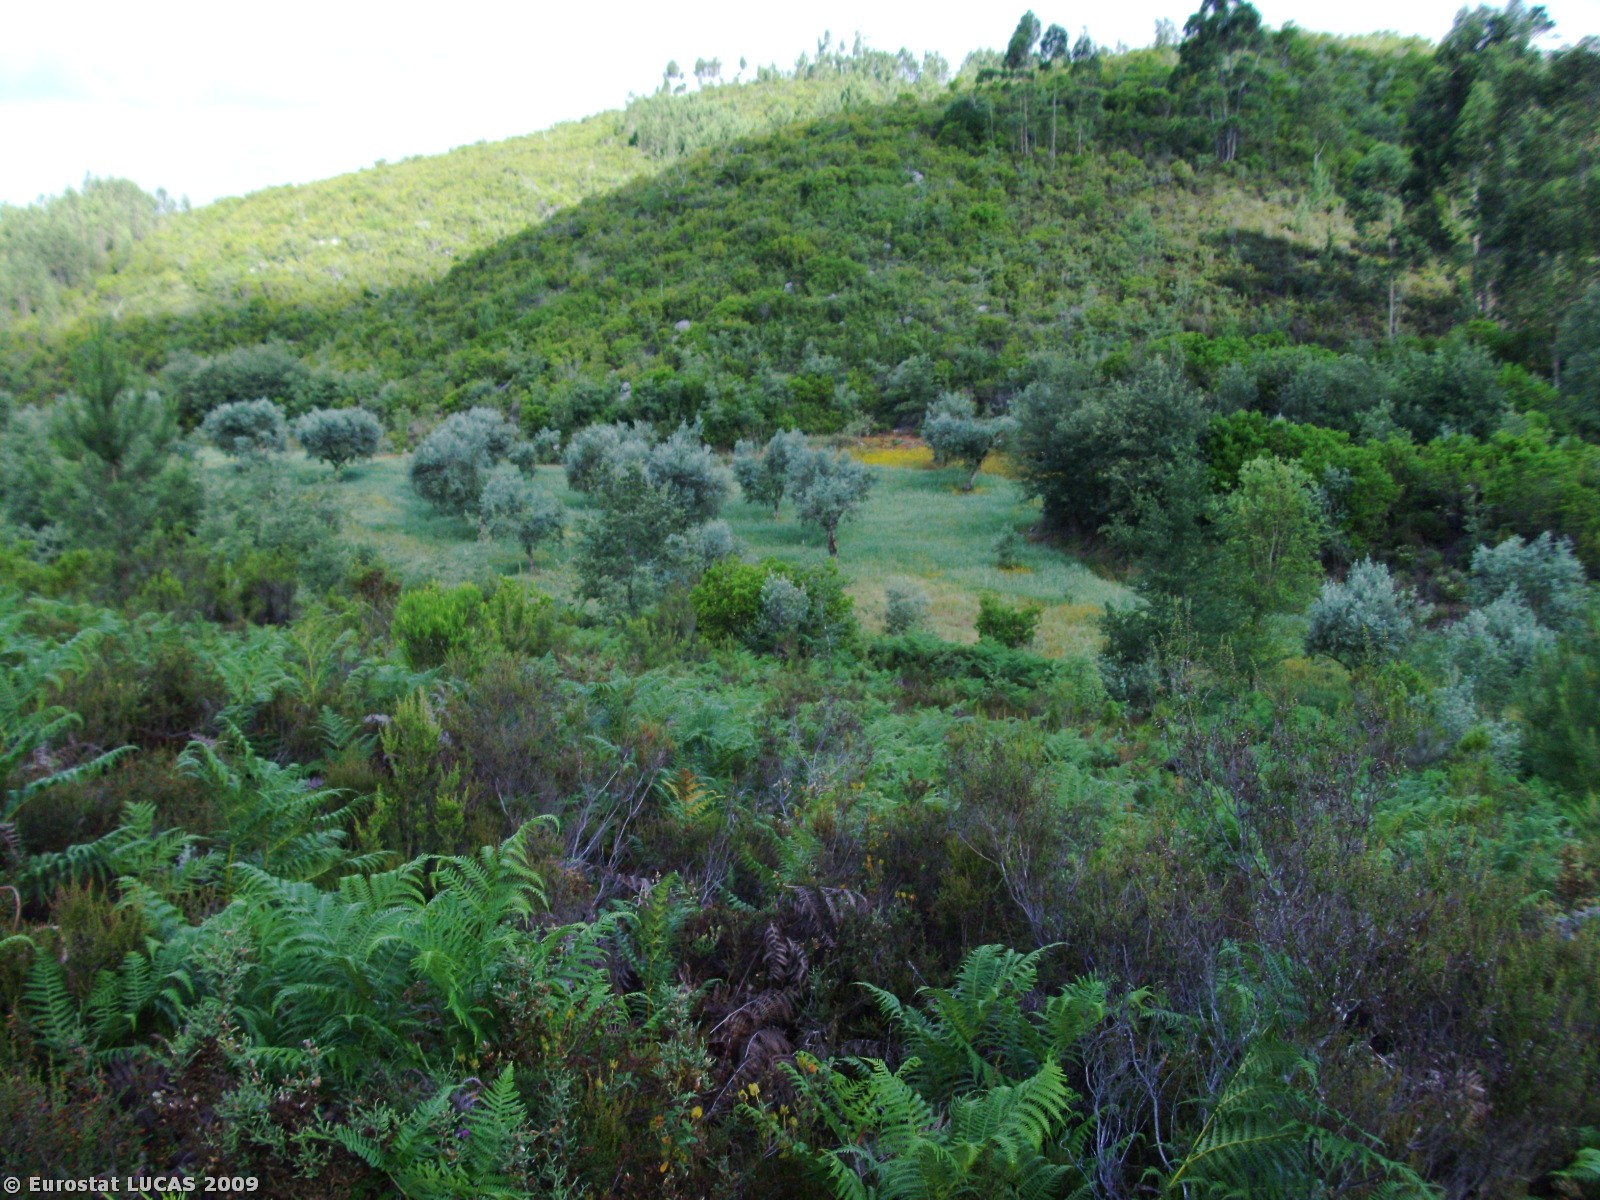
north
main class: Shrubland
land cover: Shrubland with sparse tree cover
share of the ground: > 75 %
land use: Unused
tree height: > 5 m
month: June
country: PT
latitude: 39.8484
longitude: -8.4624
